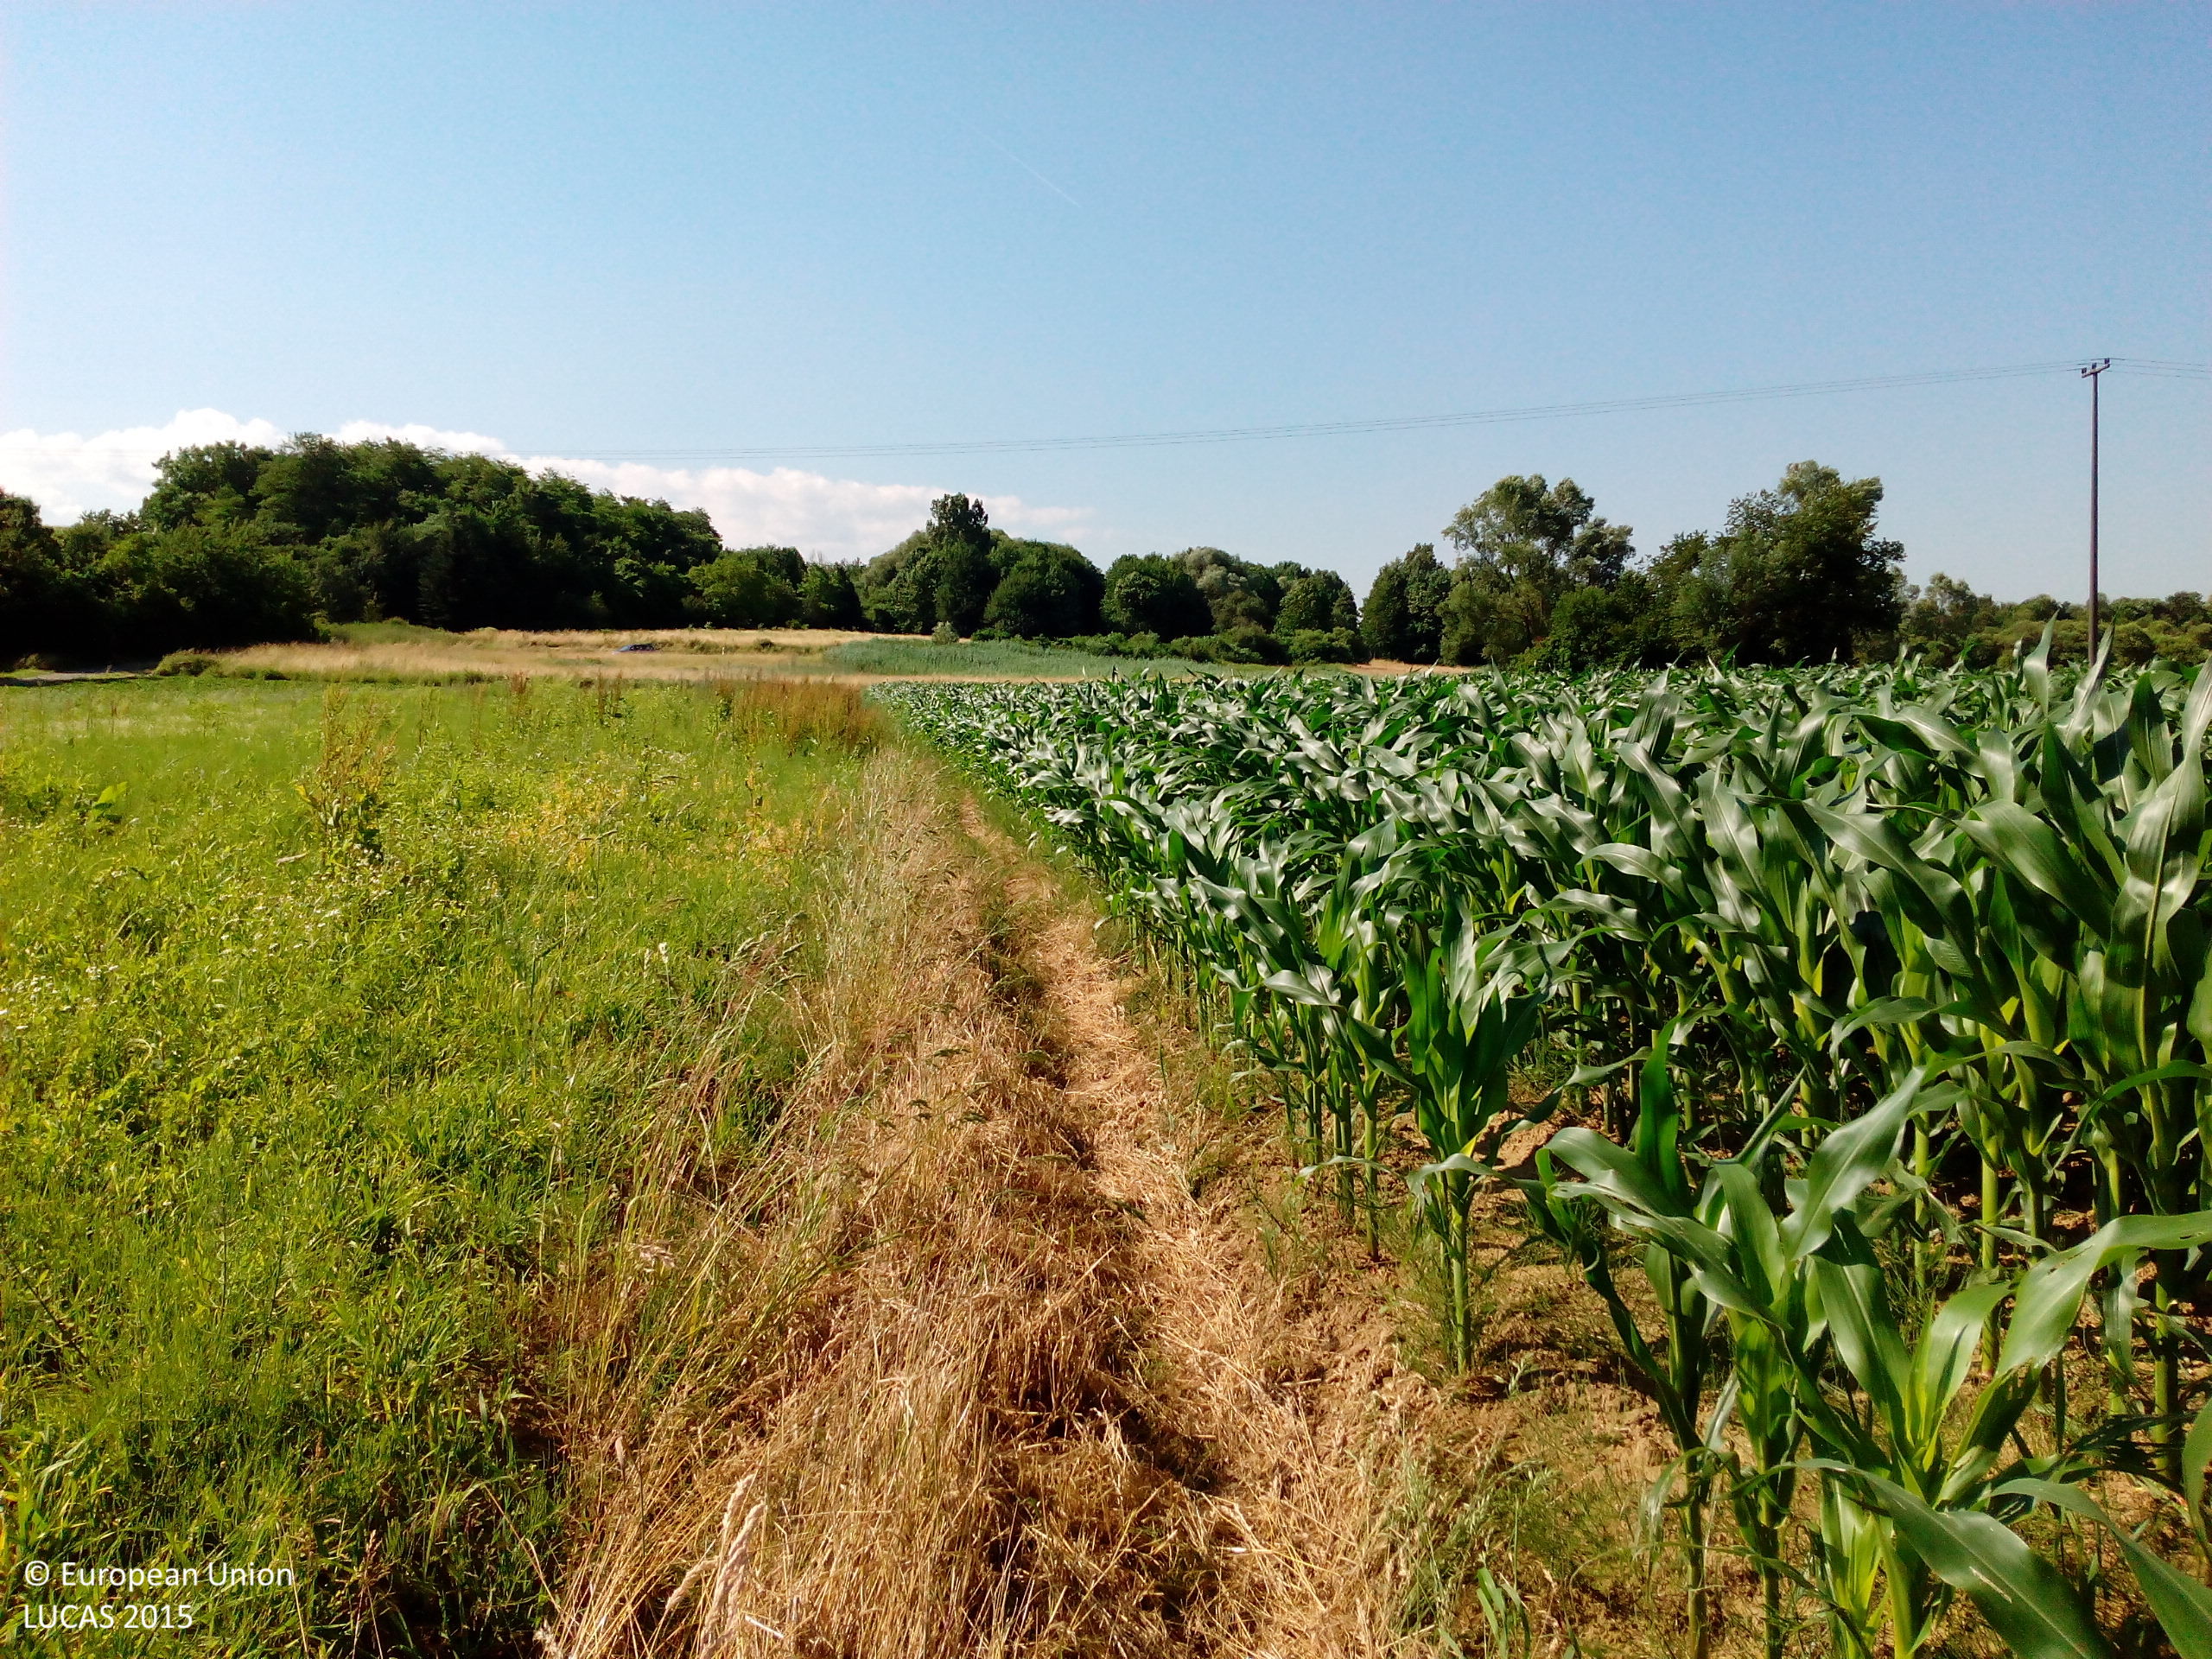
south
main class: Cropland
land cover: Maize
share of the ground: > 75 %
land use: Agriculture (excluding fallow land and kitchen gardens)
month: June
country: DE
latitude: 48.7482
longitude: 8.1647
